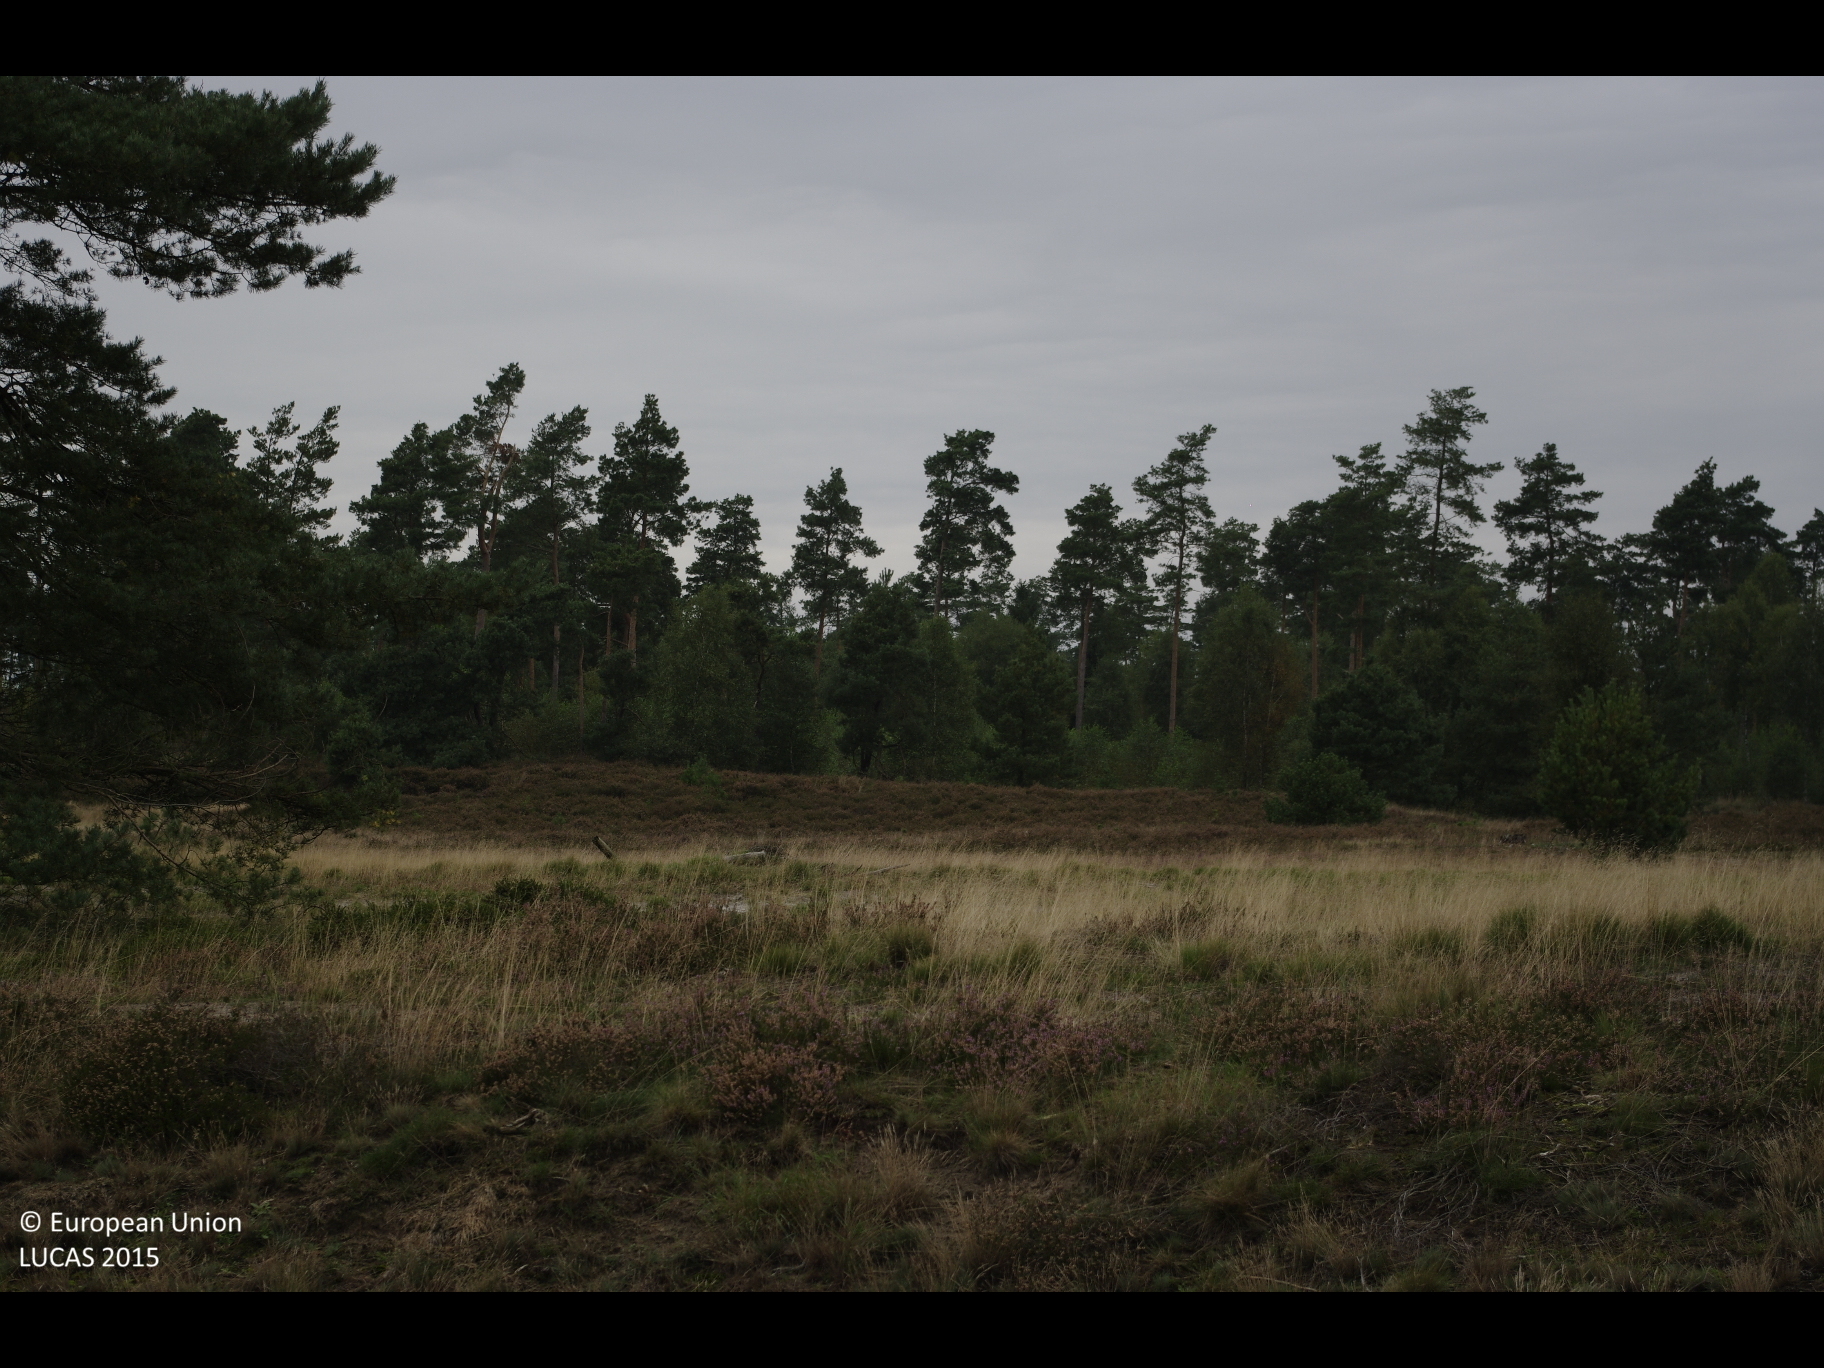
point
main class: Woodland
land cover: Pine dominated coniferous woodland
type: hemiboreal forest and nemoral coniferous forest and mixed broadleaved-coniferous forest
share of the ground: 50 - 75 %
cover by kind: coniferous forest trees 60 %, shrubs 40 %
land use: Forestry
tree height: > 5 m
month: September
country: DE
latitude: 53.1323
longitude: 9.9253
